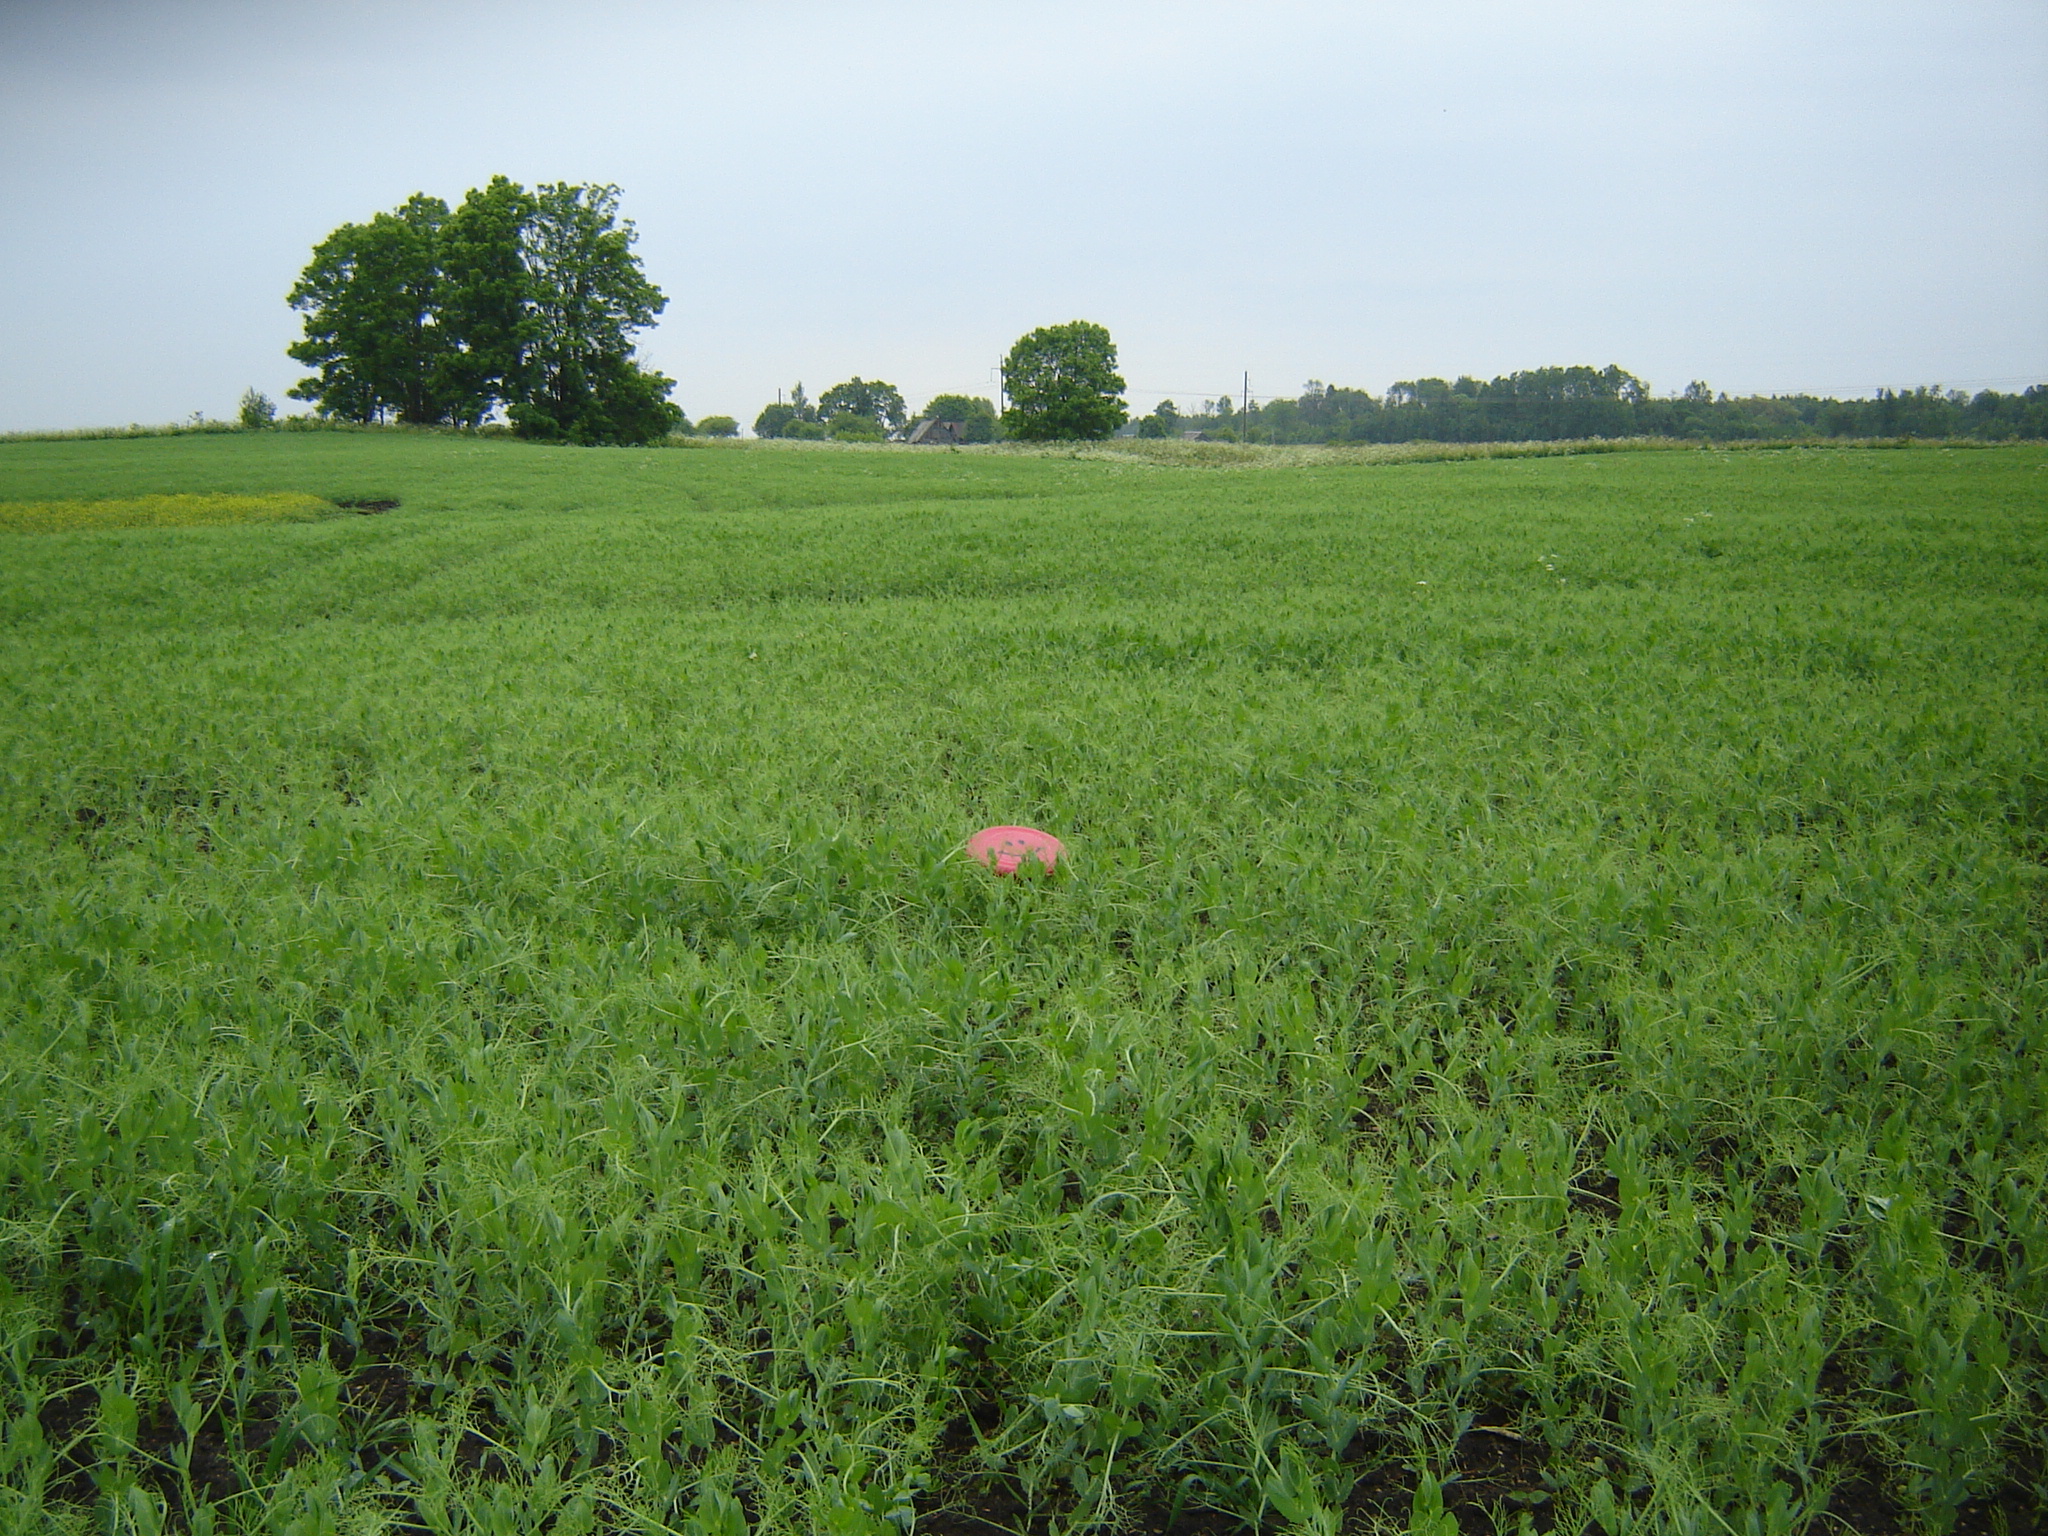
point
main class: Cropland
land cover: Dry pulses
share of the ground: > 75 %
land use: Agriculture (excluding fallow land and kitchen gardens)
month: June
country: LT
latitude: 55.5606
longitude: 25.2596
